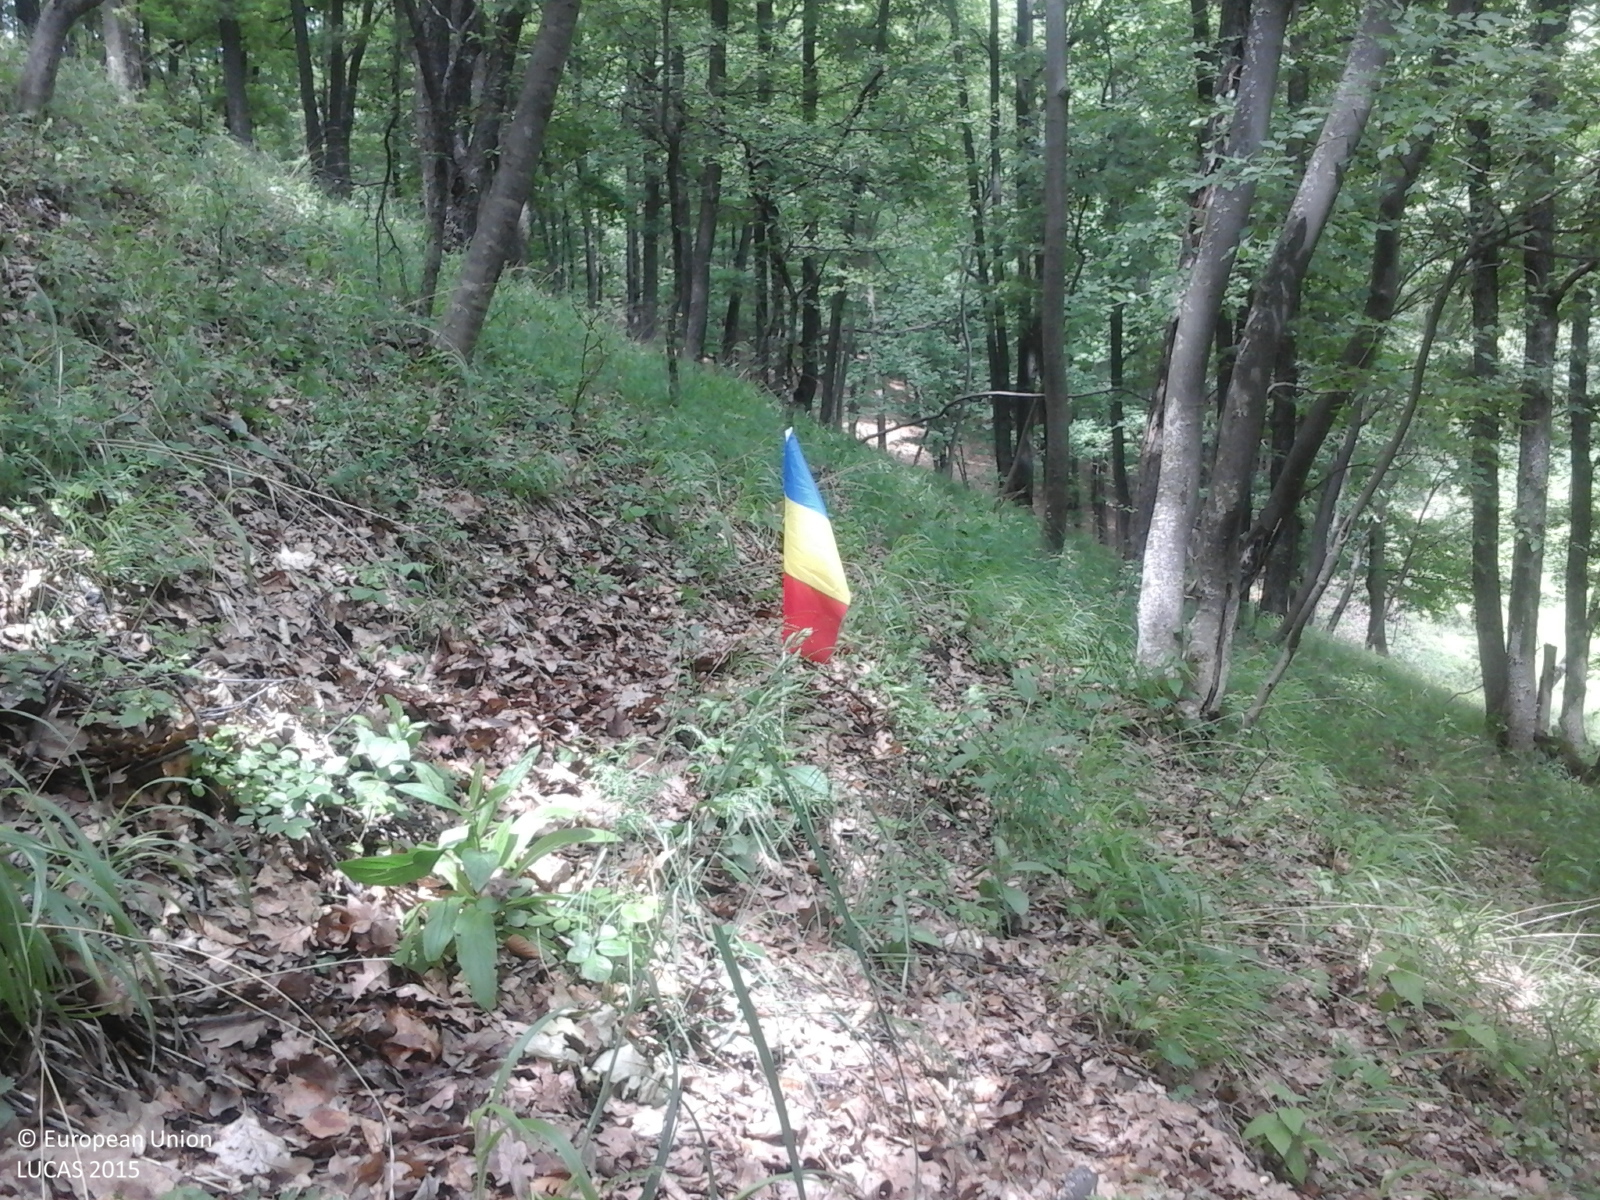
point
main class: Woodland
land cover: Broadleaved woodland
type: beech forest
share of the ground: > 75 %
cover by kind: broadleaved forest trees 100 %
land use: Forestry
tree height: > 5 m
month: May
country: RO
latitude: 45.2786
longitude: 26.2689
